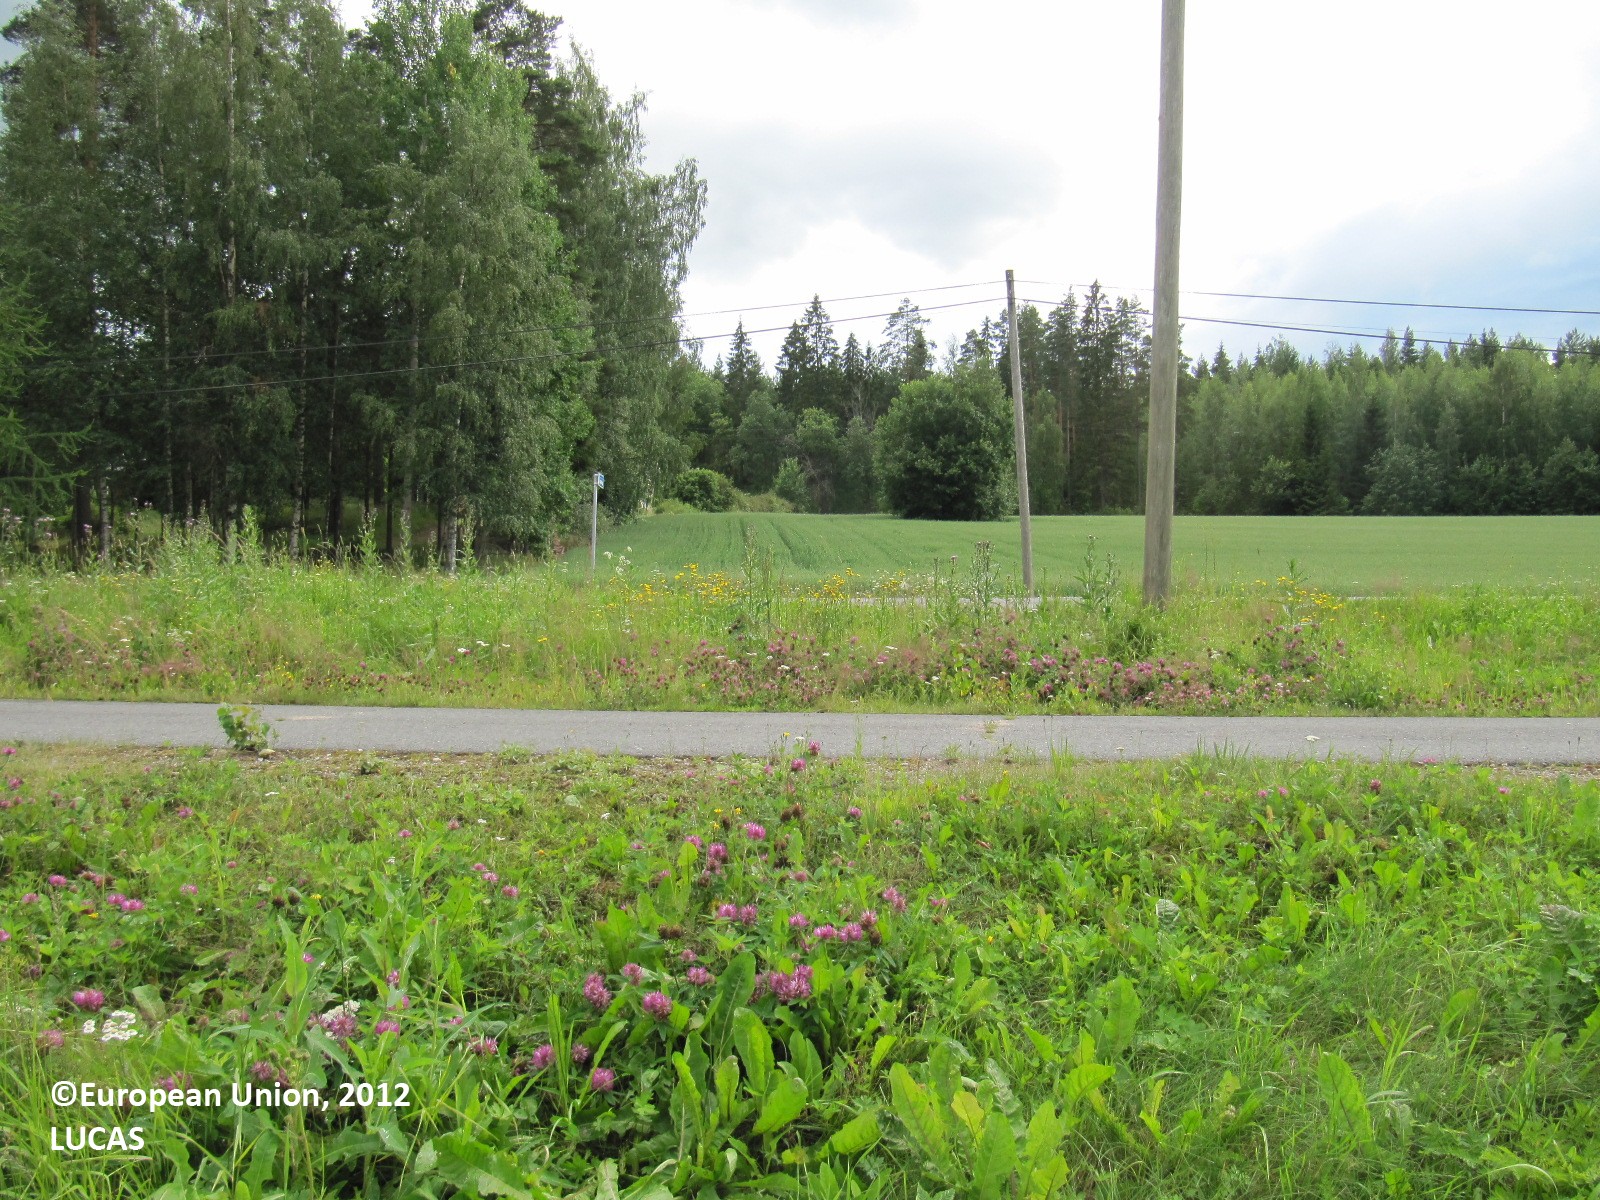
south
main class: Cropland
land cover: Common wheat
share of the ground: > 75 %
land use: Agriculture (excluding fallow land and kitchen gardens)
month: July
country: FI
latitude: 60.9112
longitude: 24.6930
